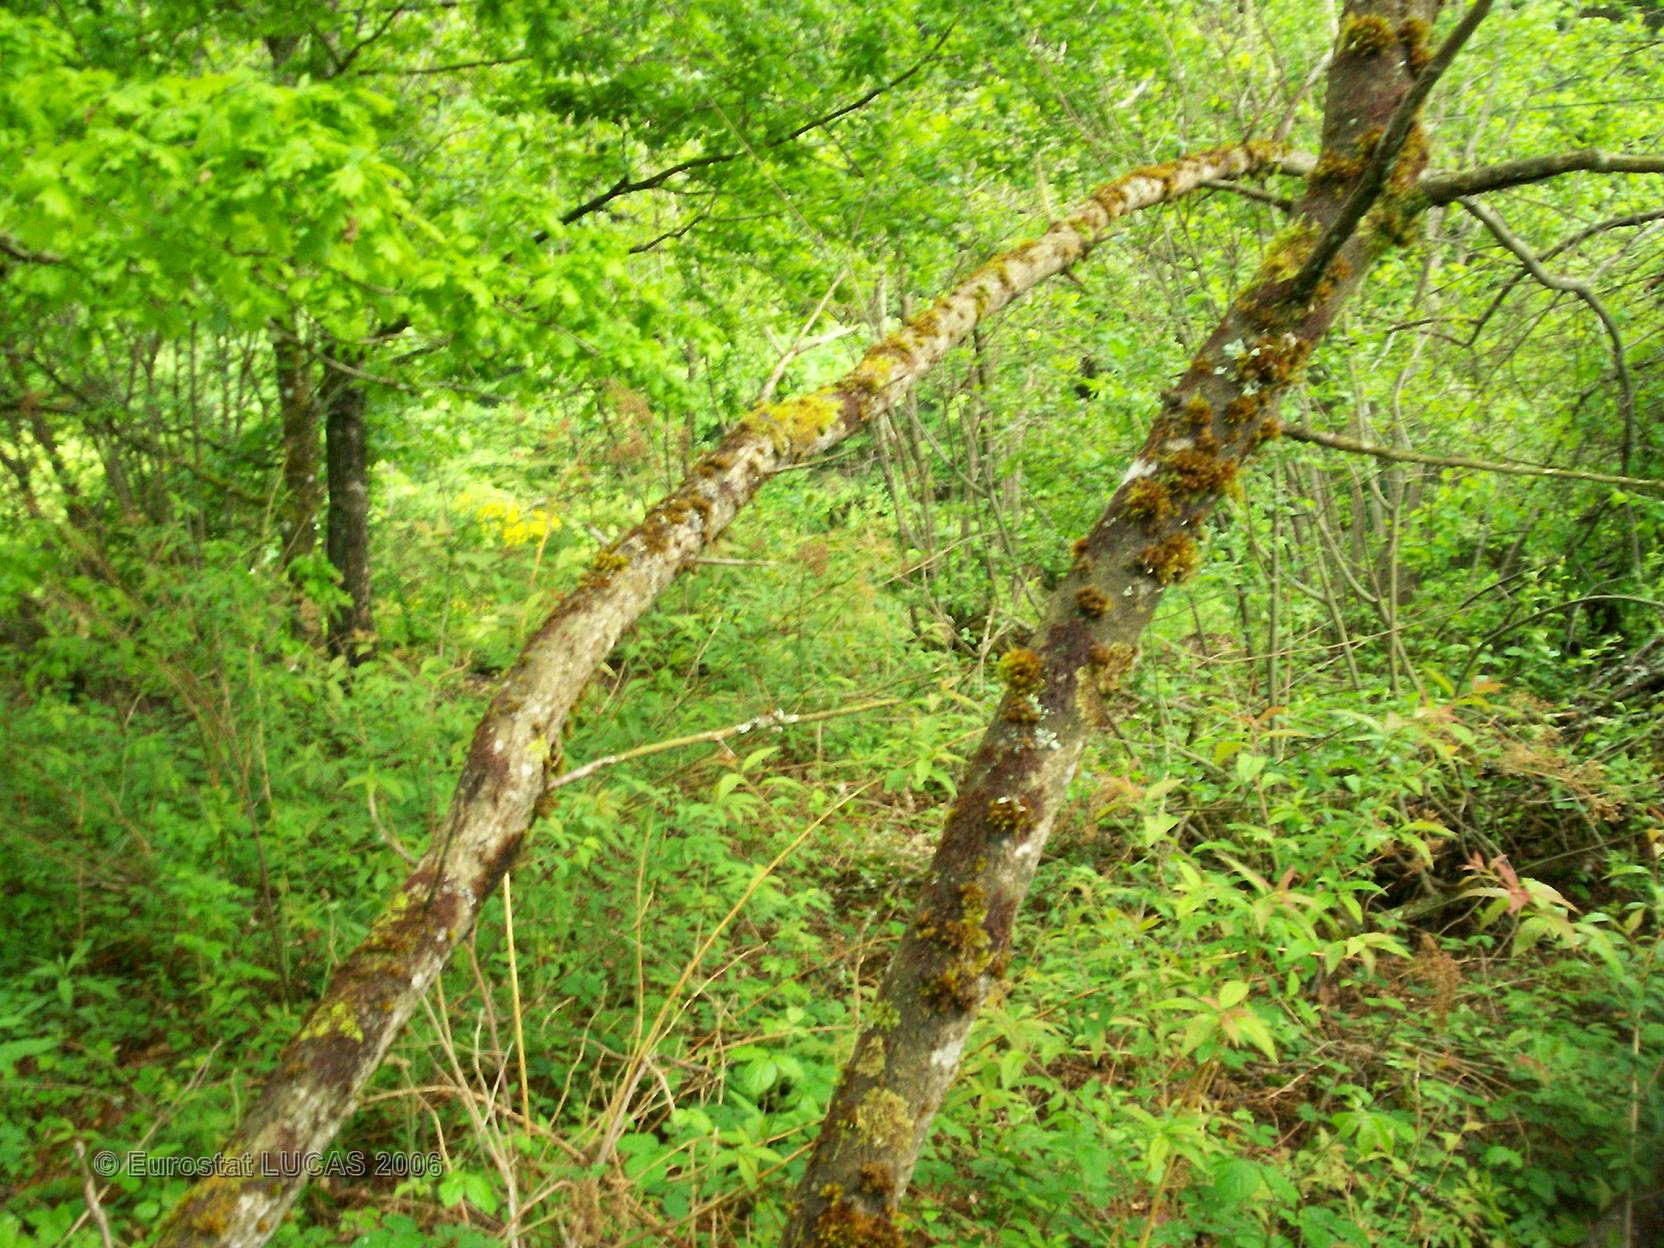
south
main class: Woodland
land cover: Broadleaved forest
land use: Unused
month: June
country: FR
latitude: 47.9423
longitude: 6.7747
